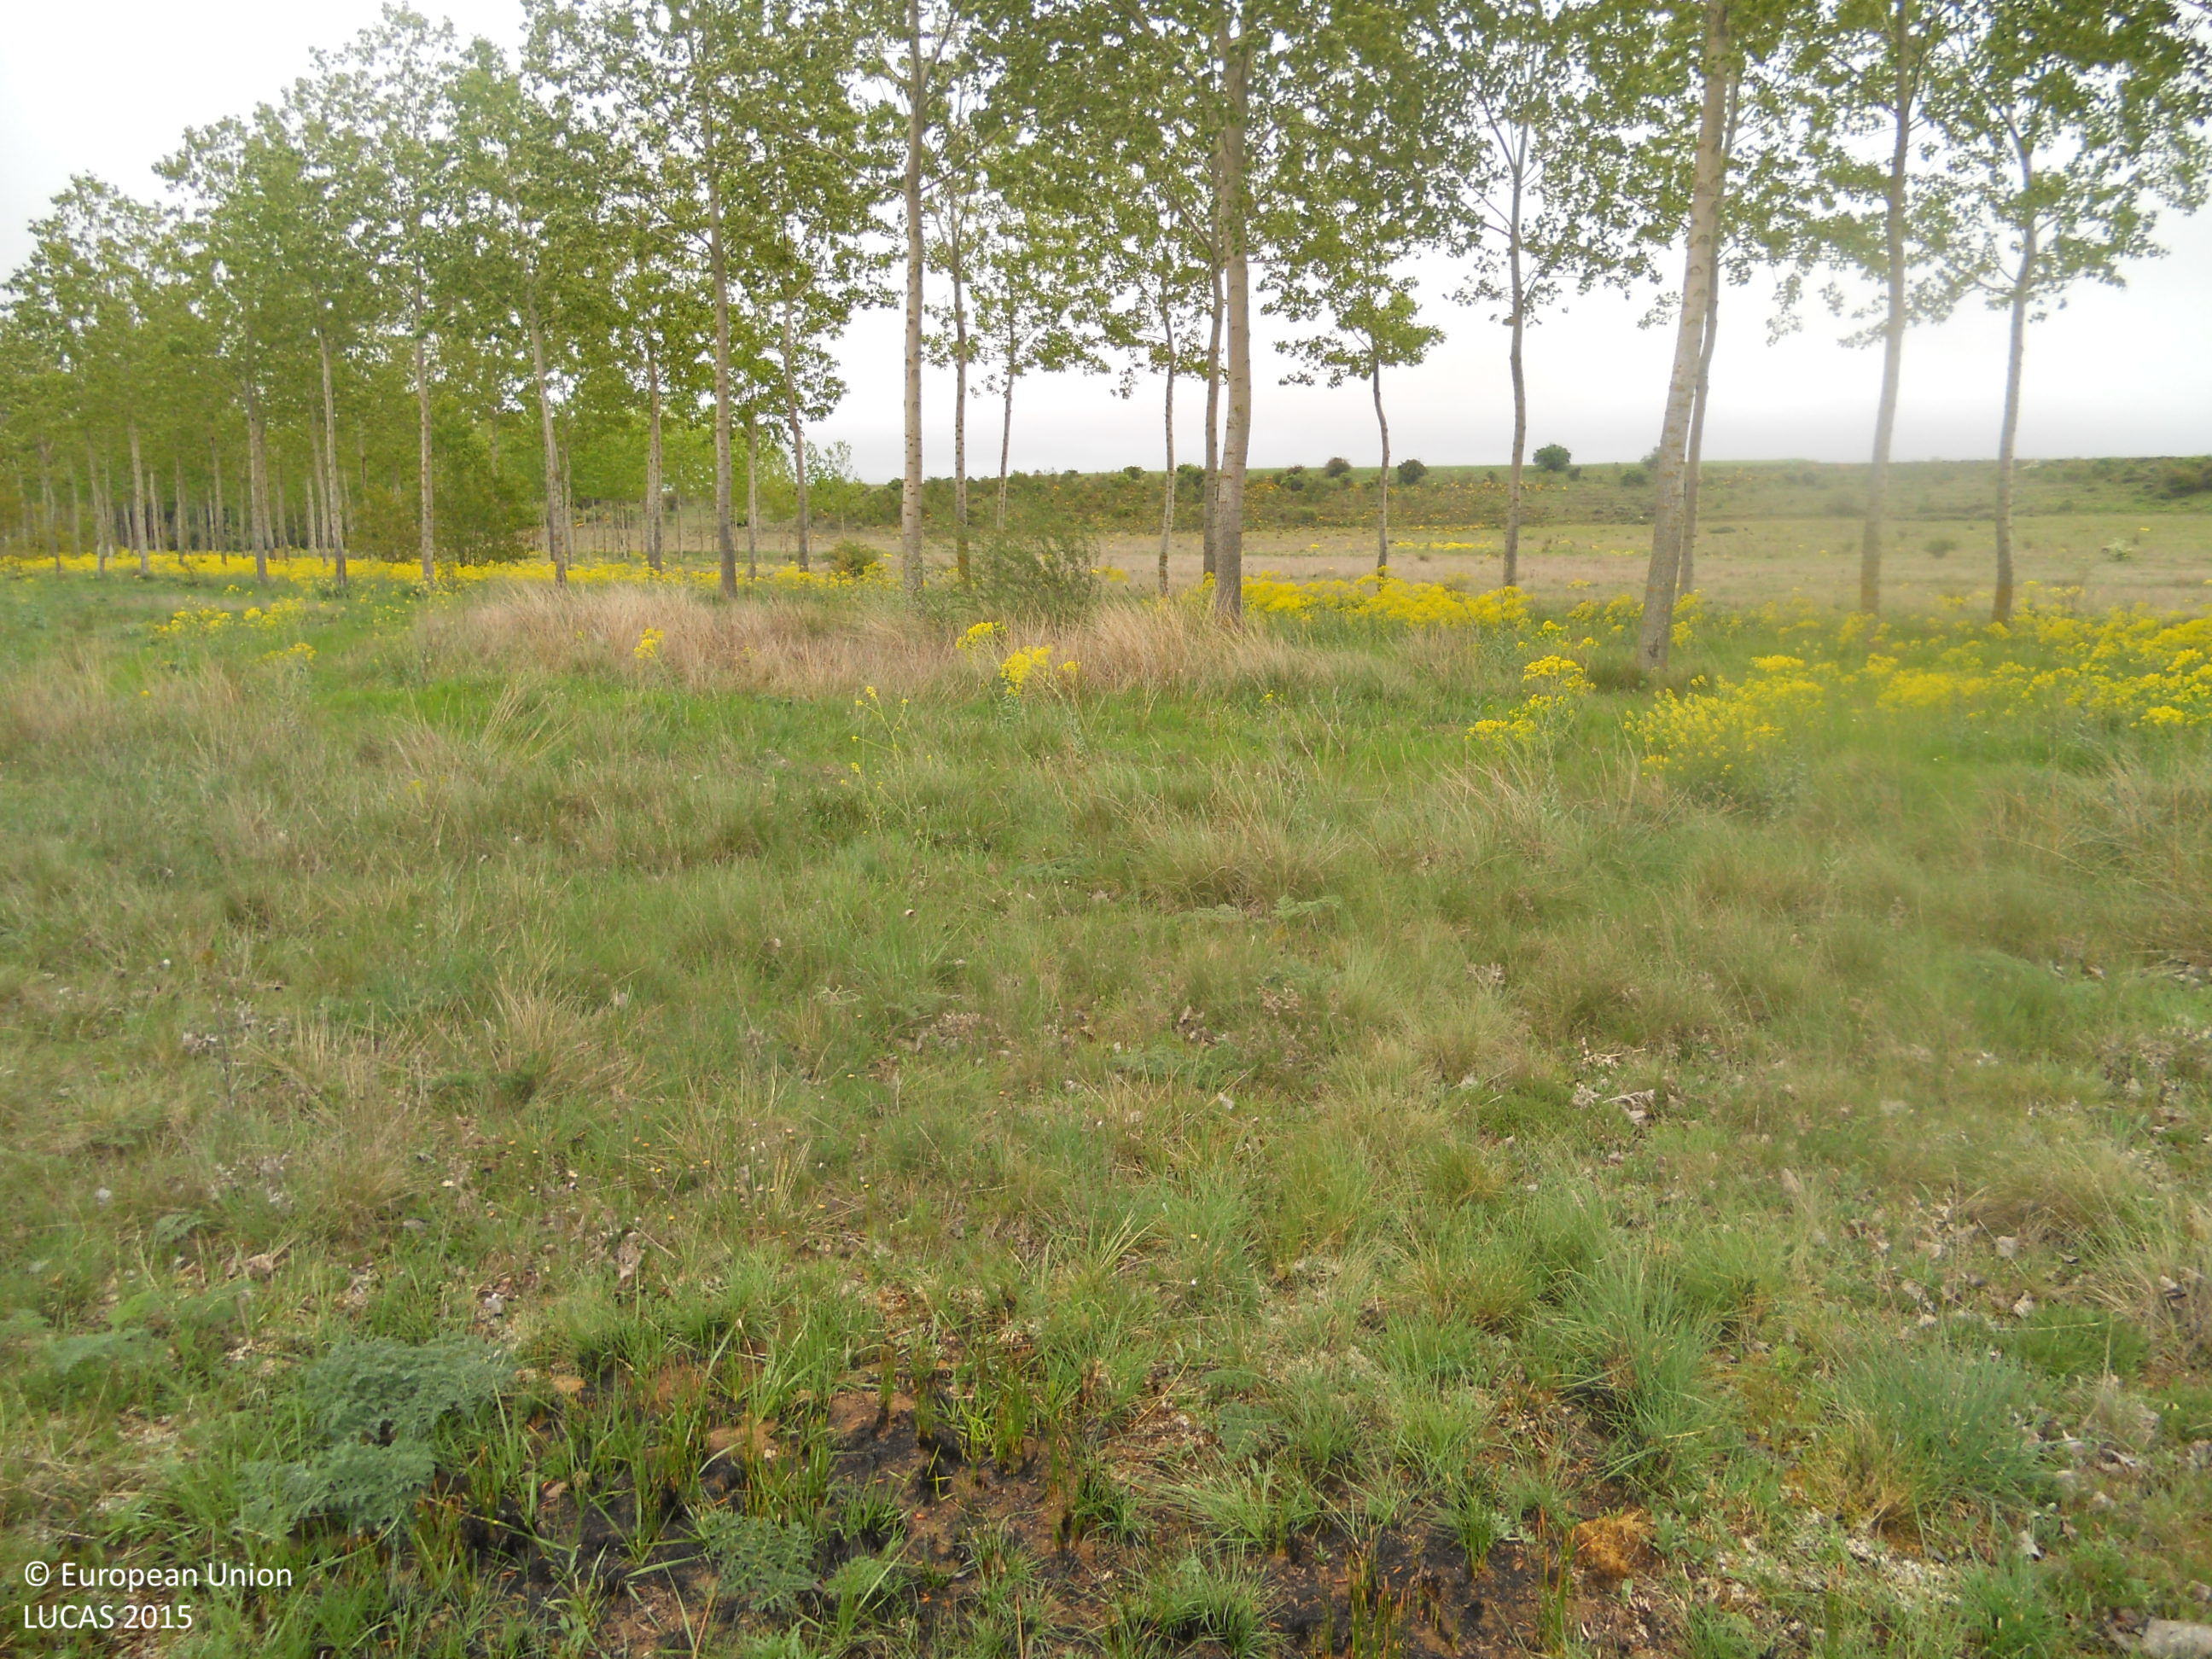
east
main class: Grassland
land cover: Grassland without tree/shrub cover
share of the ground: > 75 %
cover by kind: herbaceous plants 95 %, shrubs 5 %
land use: Agriculture (excluding fallow land and kitchen gardens)
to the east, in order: Grassland without tree/shrub cover; Broadleaved woodland; Grass margins; Rivers and streams; Grassland without tree/shrub cover; Broadleaved woodland; Grassland without tree/shrub cover; Common wheat
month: May
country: ES
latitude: 42.4697
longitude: -5.3305
